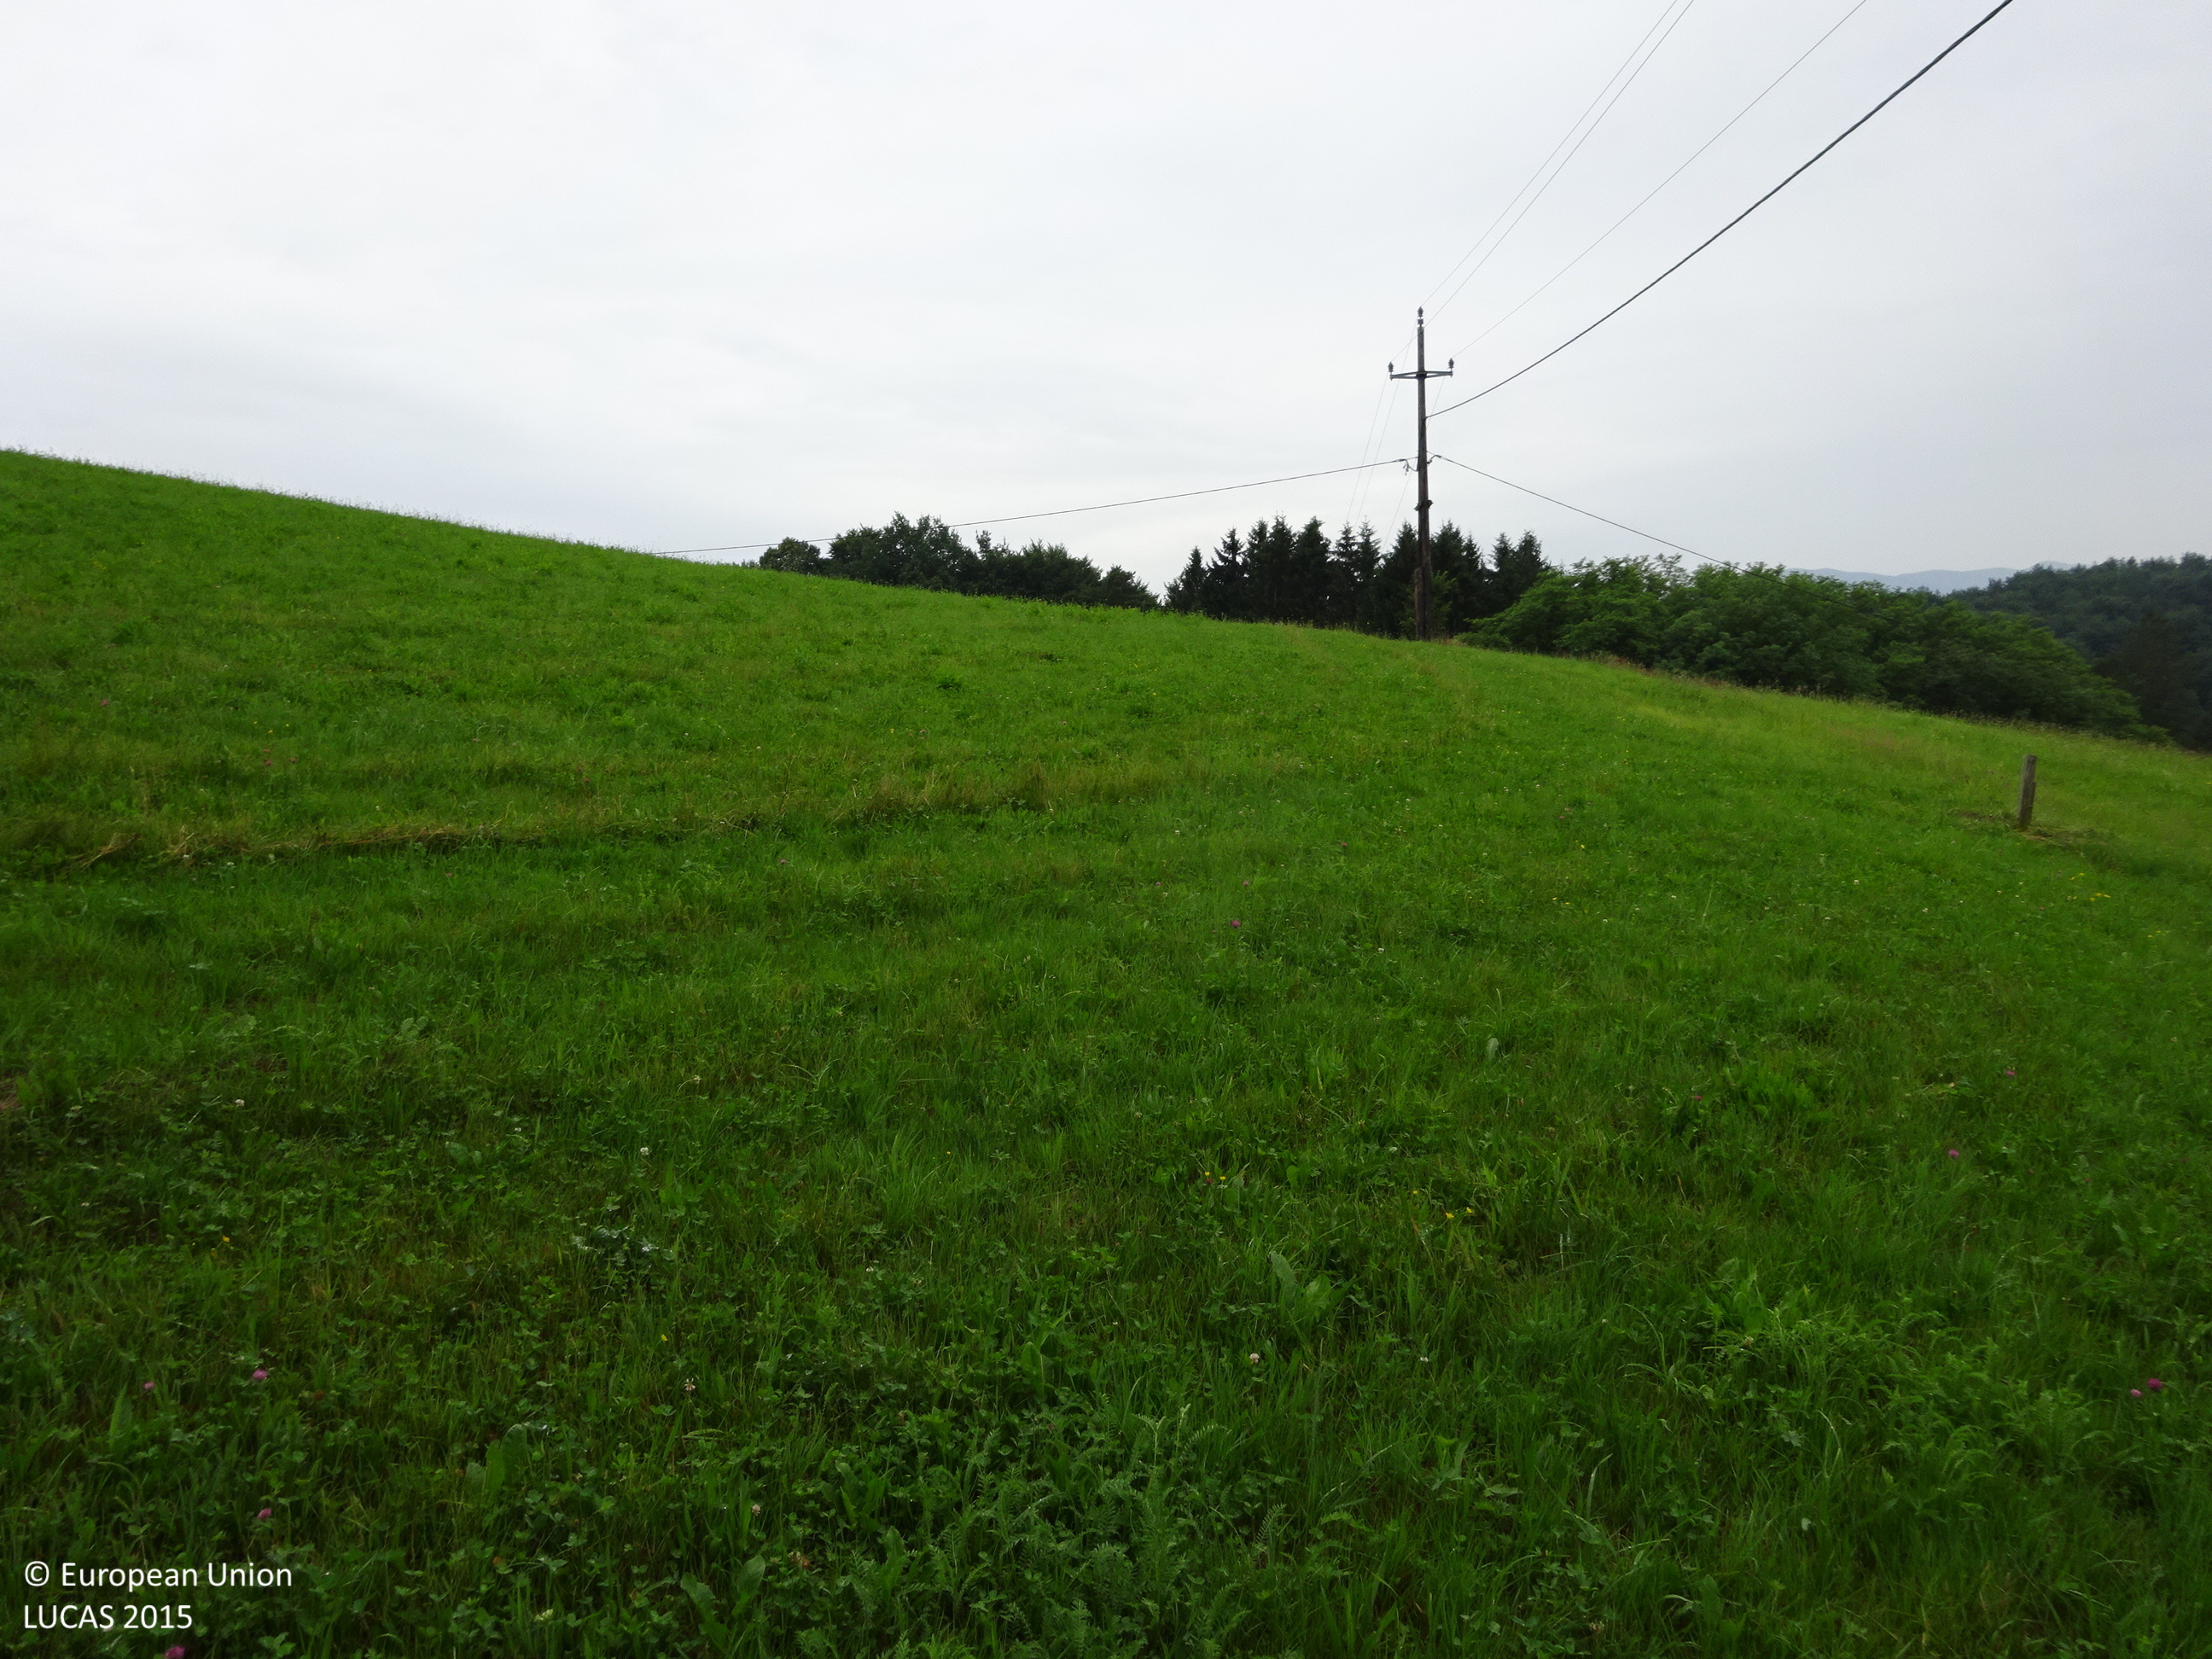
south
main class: Grassland
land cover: Grassland without tree/shrub cover
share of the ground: > 75 %
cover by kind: herbaceous plants 100 %
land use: Agriculture (excluding fallow land and kitchen gardens)
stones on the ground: < 10 %
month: June
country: AT
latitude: 46.7393
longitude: 15.3781
